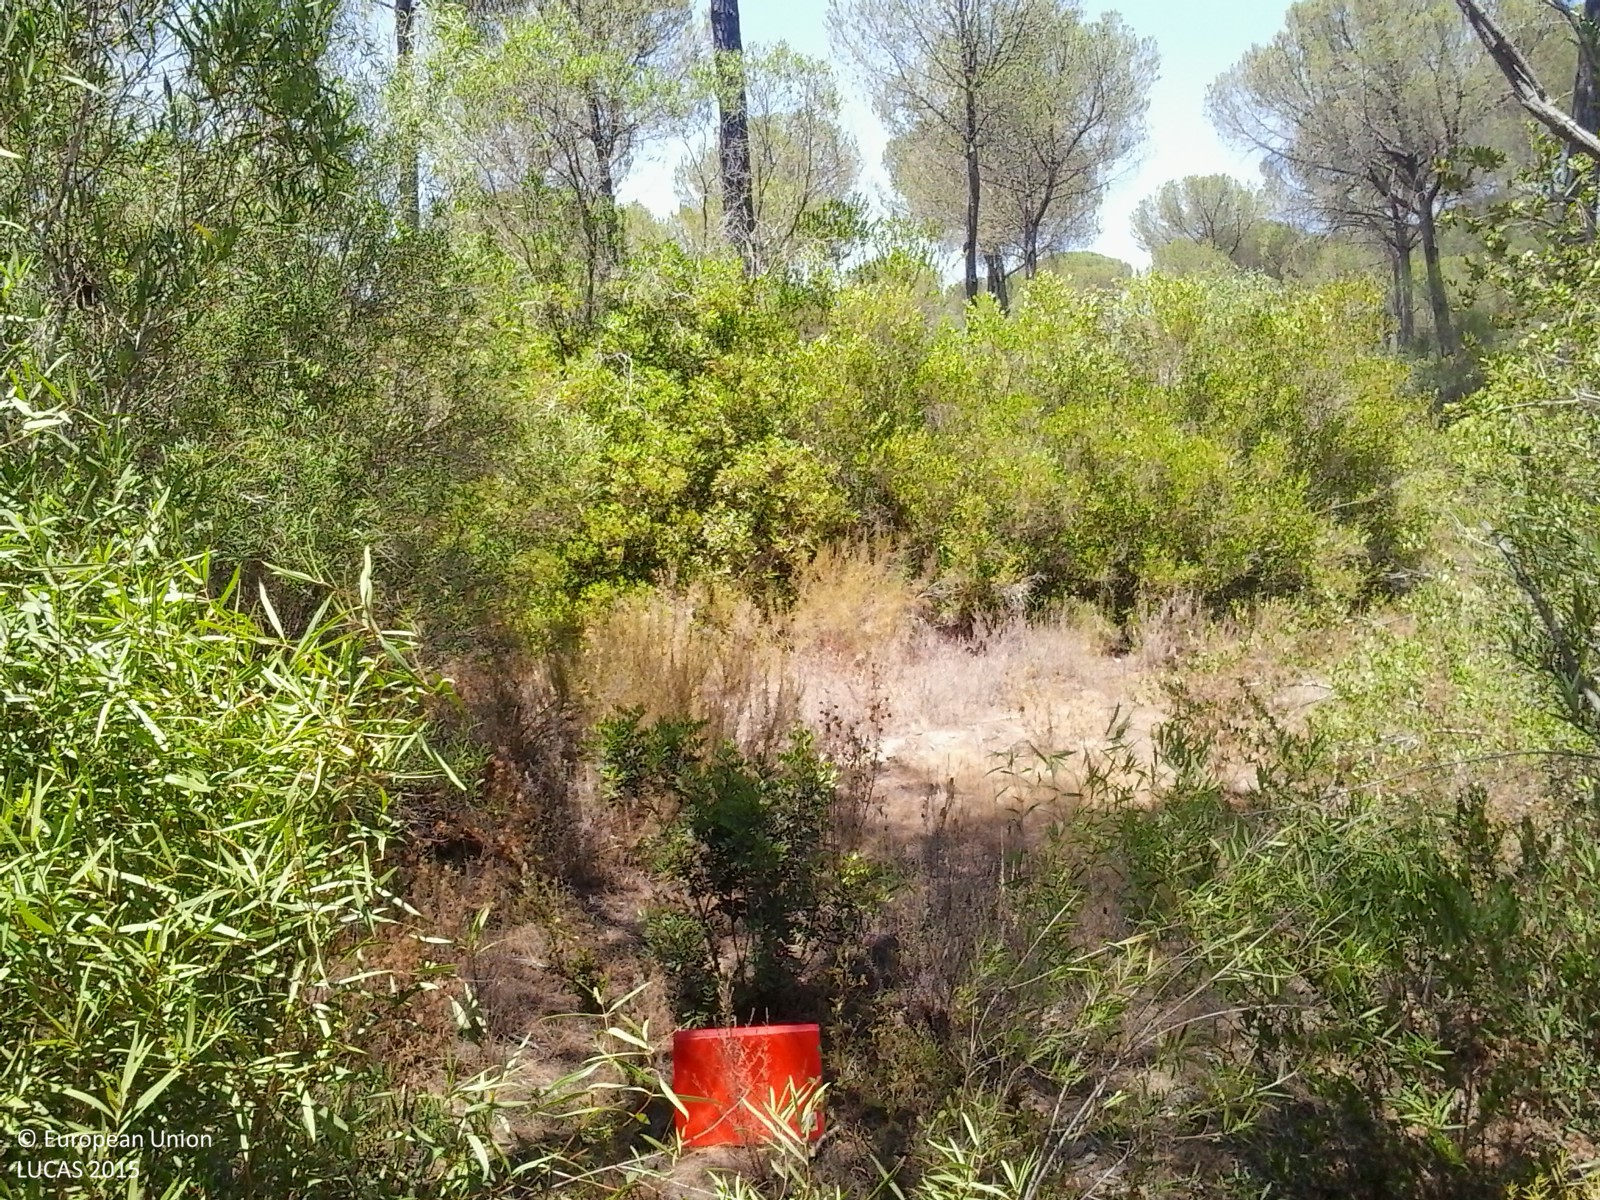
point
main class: Woodland
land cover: Pine dominated coniferous woodland
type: coniferous forest of the mediterranean region
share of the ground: 50 - 75 %
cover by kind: coniferous forest trees 80 %, shrubs 20 %
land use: Forestry
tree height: > 5 m
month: July
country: ES
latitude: 37.2134
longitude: -6.4234
